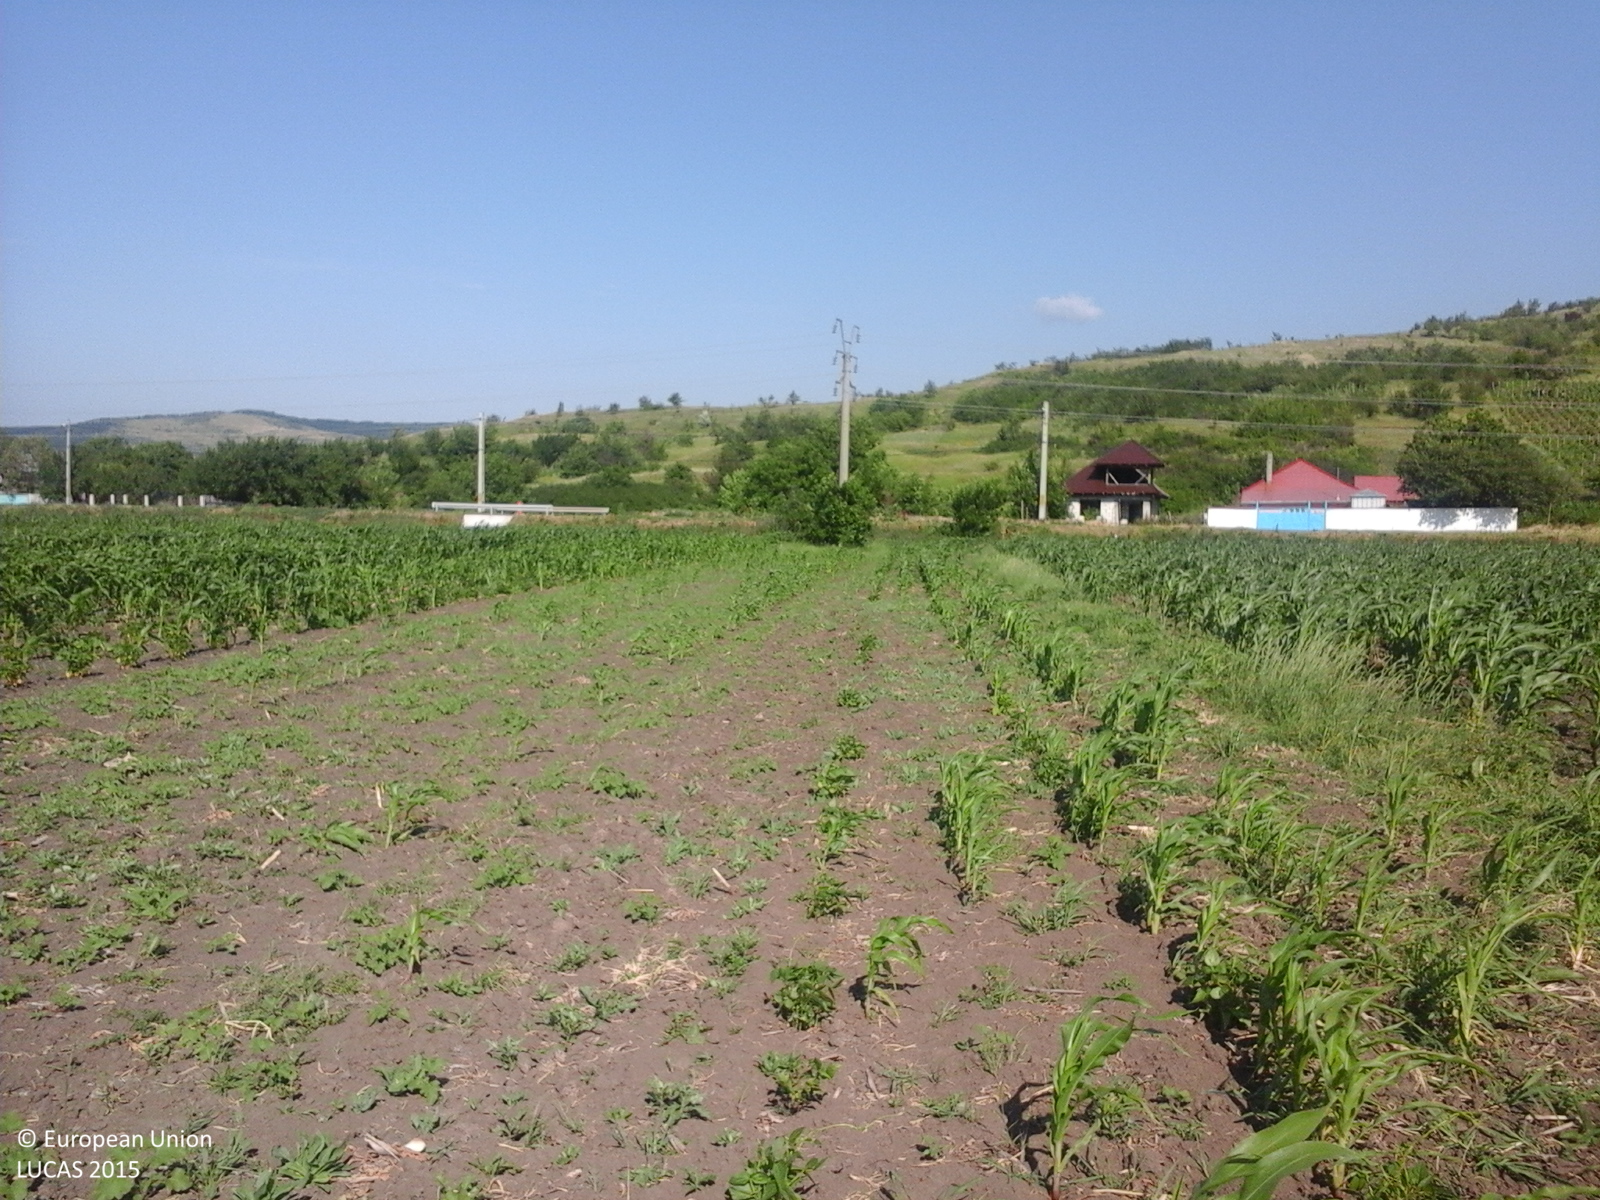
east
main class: Cropland
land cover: Maize
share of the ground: 10 - 25 %
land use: Agriculture (excluding fallow land and kitchen gardens)
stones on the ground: < 10 %
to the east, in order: Maize; Electric lines; Grass margins; Paved roads, cycling and walking lanes; Grass margins; Ditches and canals; Grass margins; Electric lines; Lucerne; Grassland with sparse tree/shrub cover
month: June
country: RO
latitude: 46.7790
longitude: 27.7903
